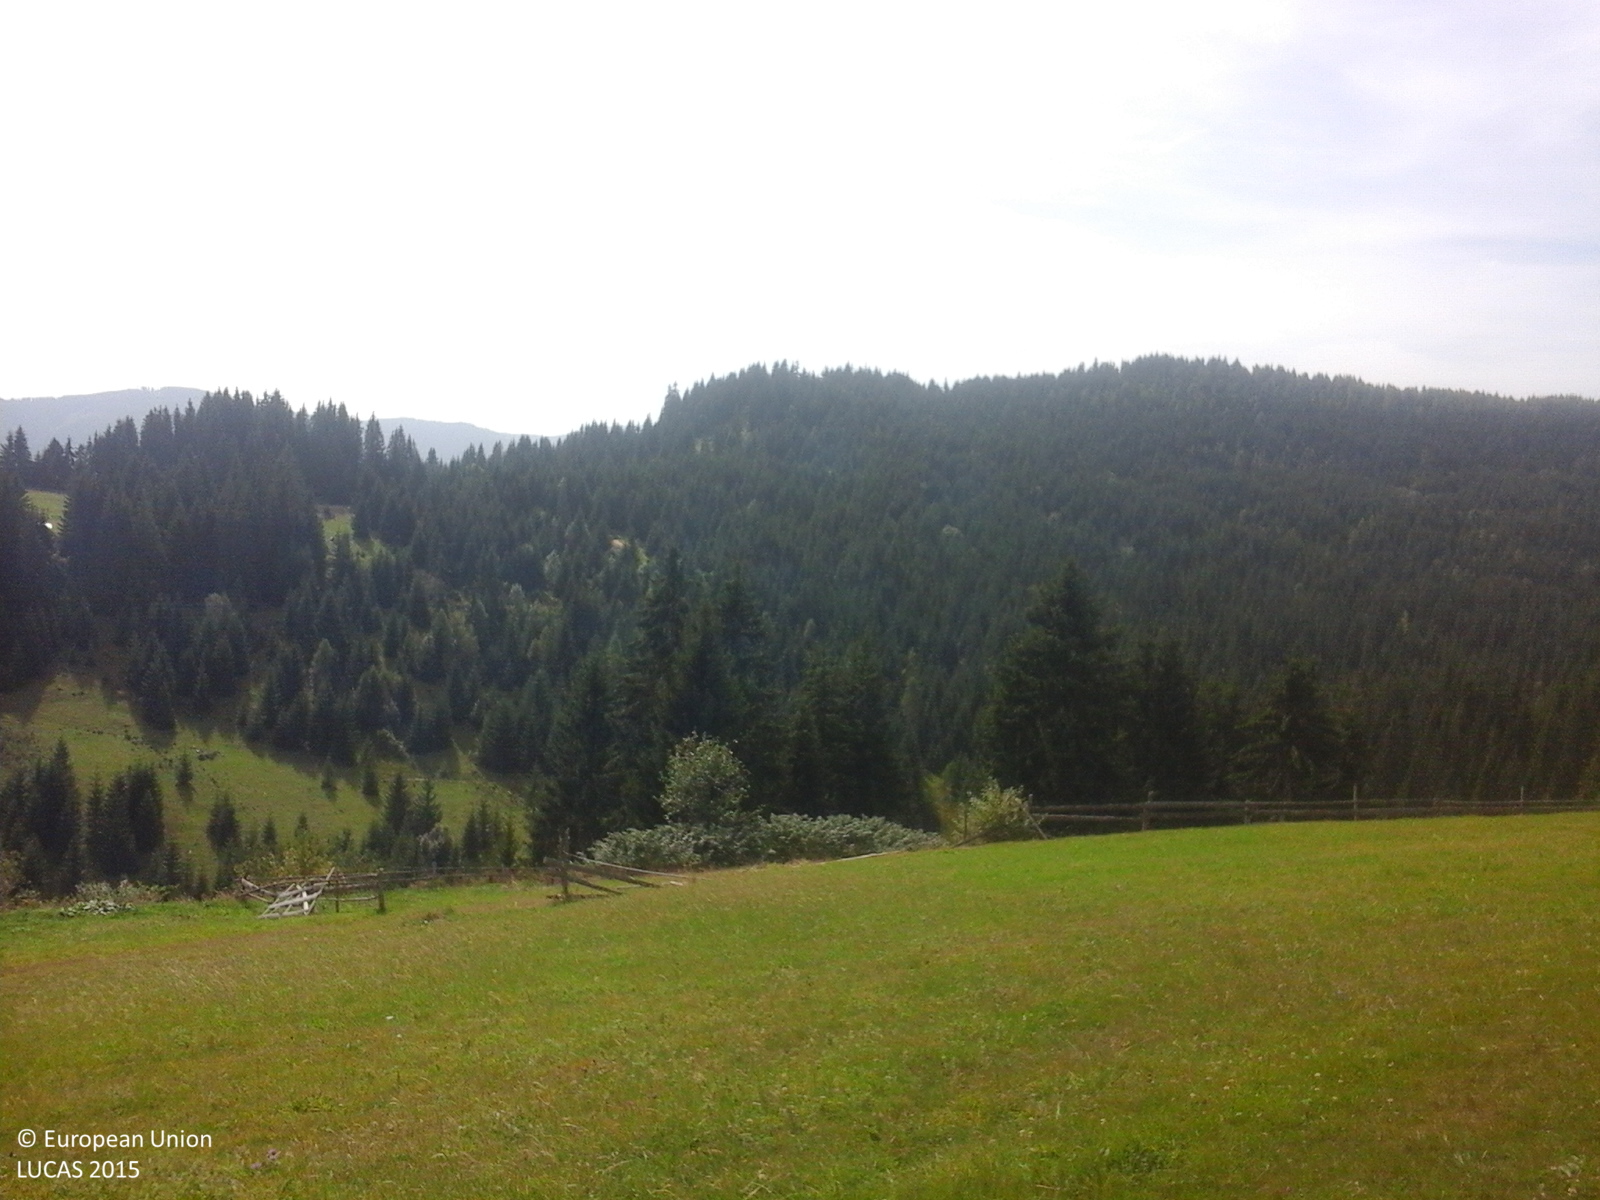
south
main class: Grassland
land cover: Grassland without tree/shrub cover
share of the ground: > 75 %
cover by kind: herbaceous plants 100 %
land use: Agriculture (excluding fallow land and kitchen gardens)
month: September
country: RO
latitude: 46.6328
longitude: 23.2703
